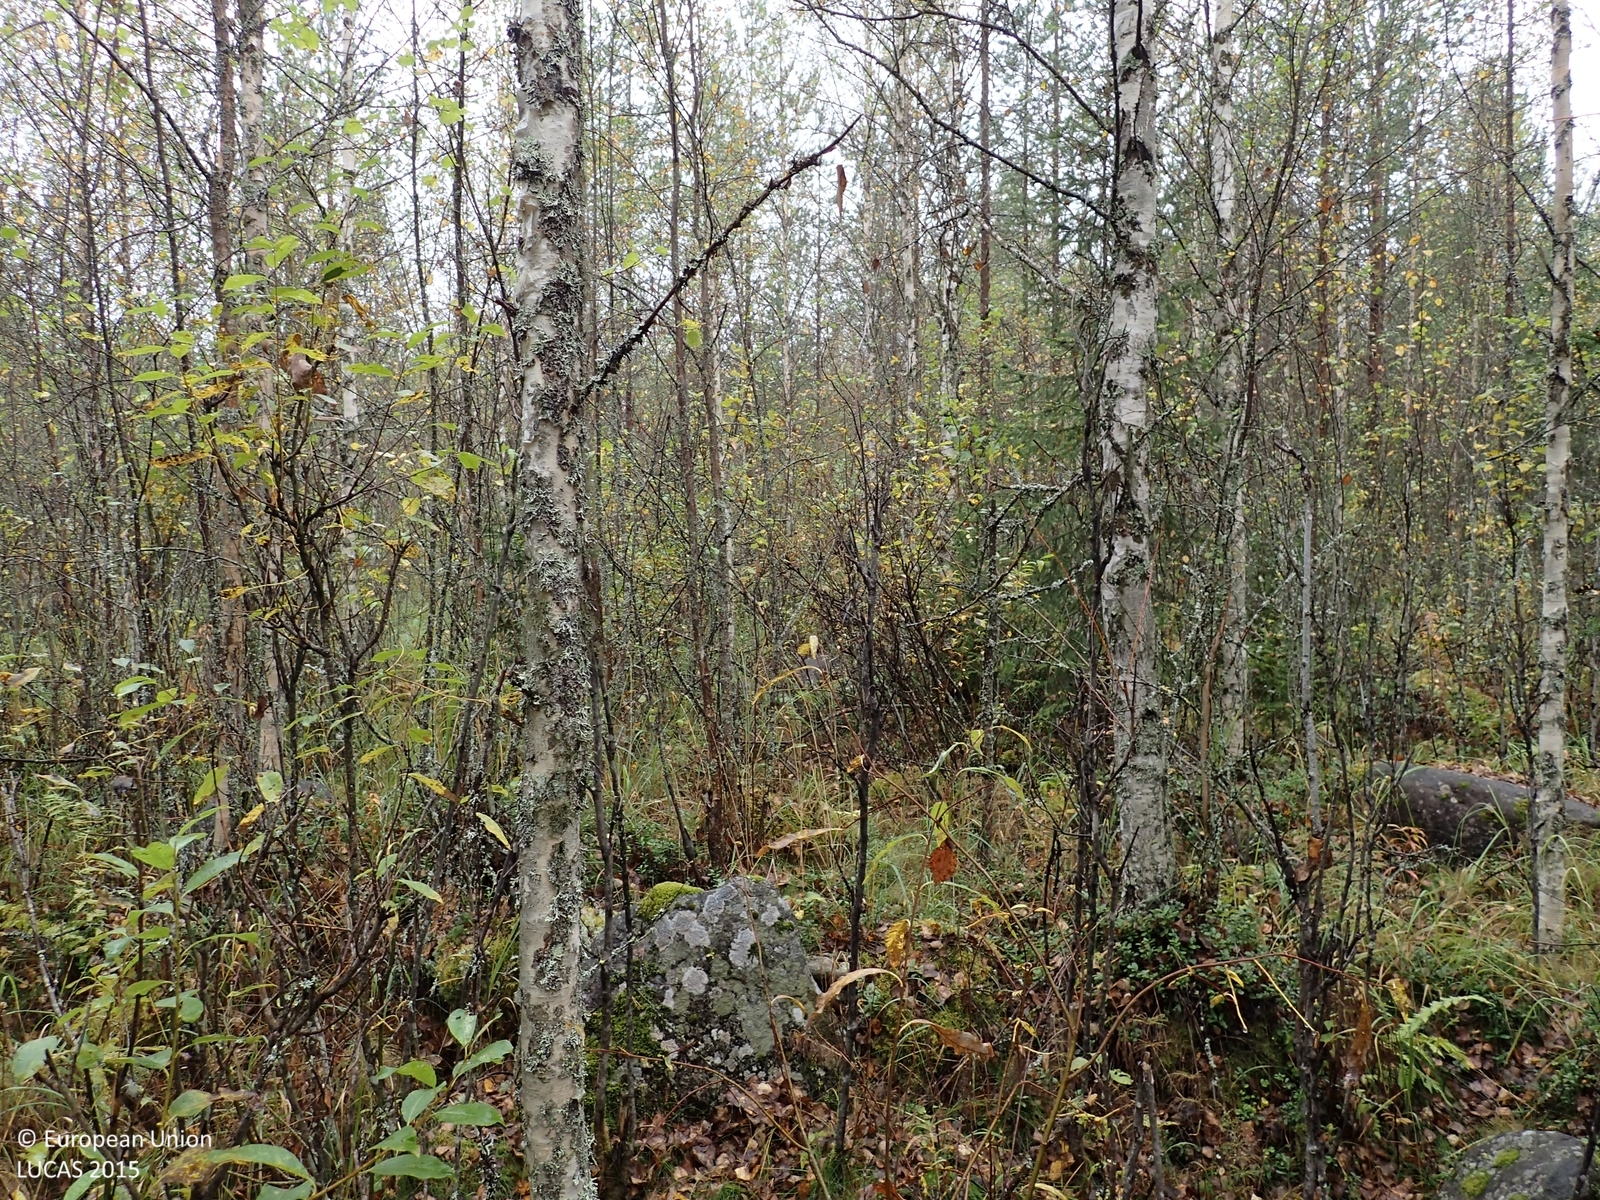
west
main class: Woodland
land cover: Broadleaved woodland
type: non-riverine alder, birch or aspen forest
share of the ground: > 75 %
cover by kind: broadleaved forest trees 70 %, coniferous forest trees 10 %, herbaceous plants 10 %, shrubs 5 %, lichens and mosses 5 %
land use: Forestry
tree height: < 5 m
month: September
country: FI
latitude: 63.2600
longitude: 25.5029
